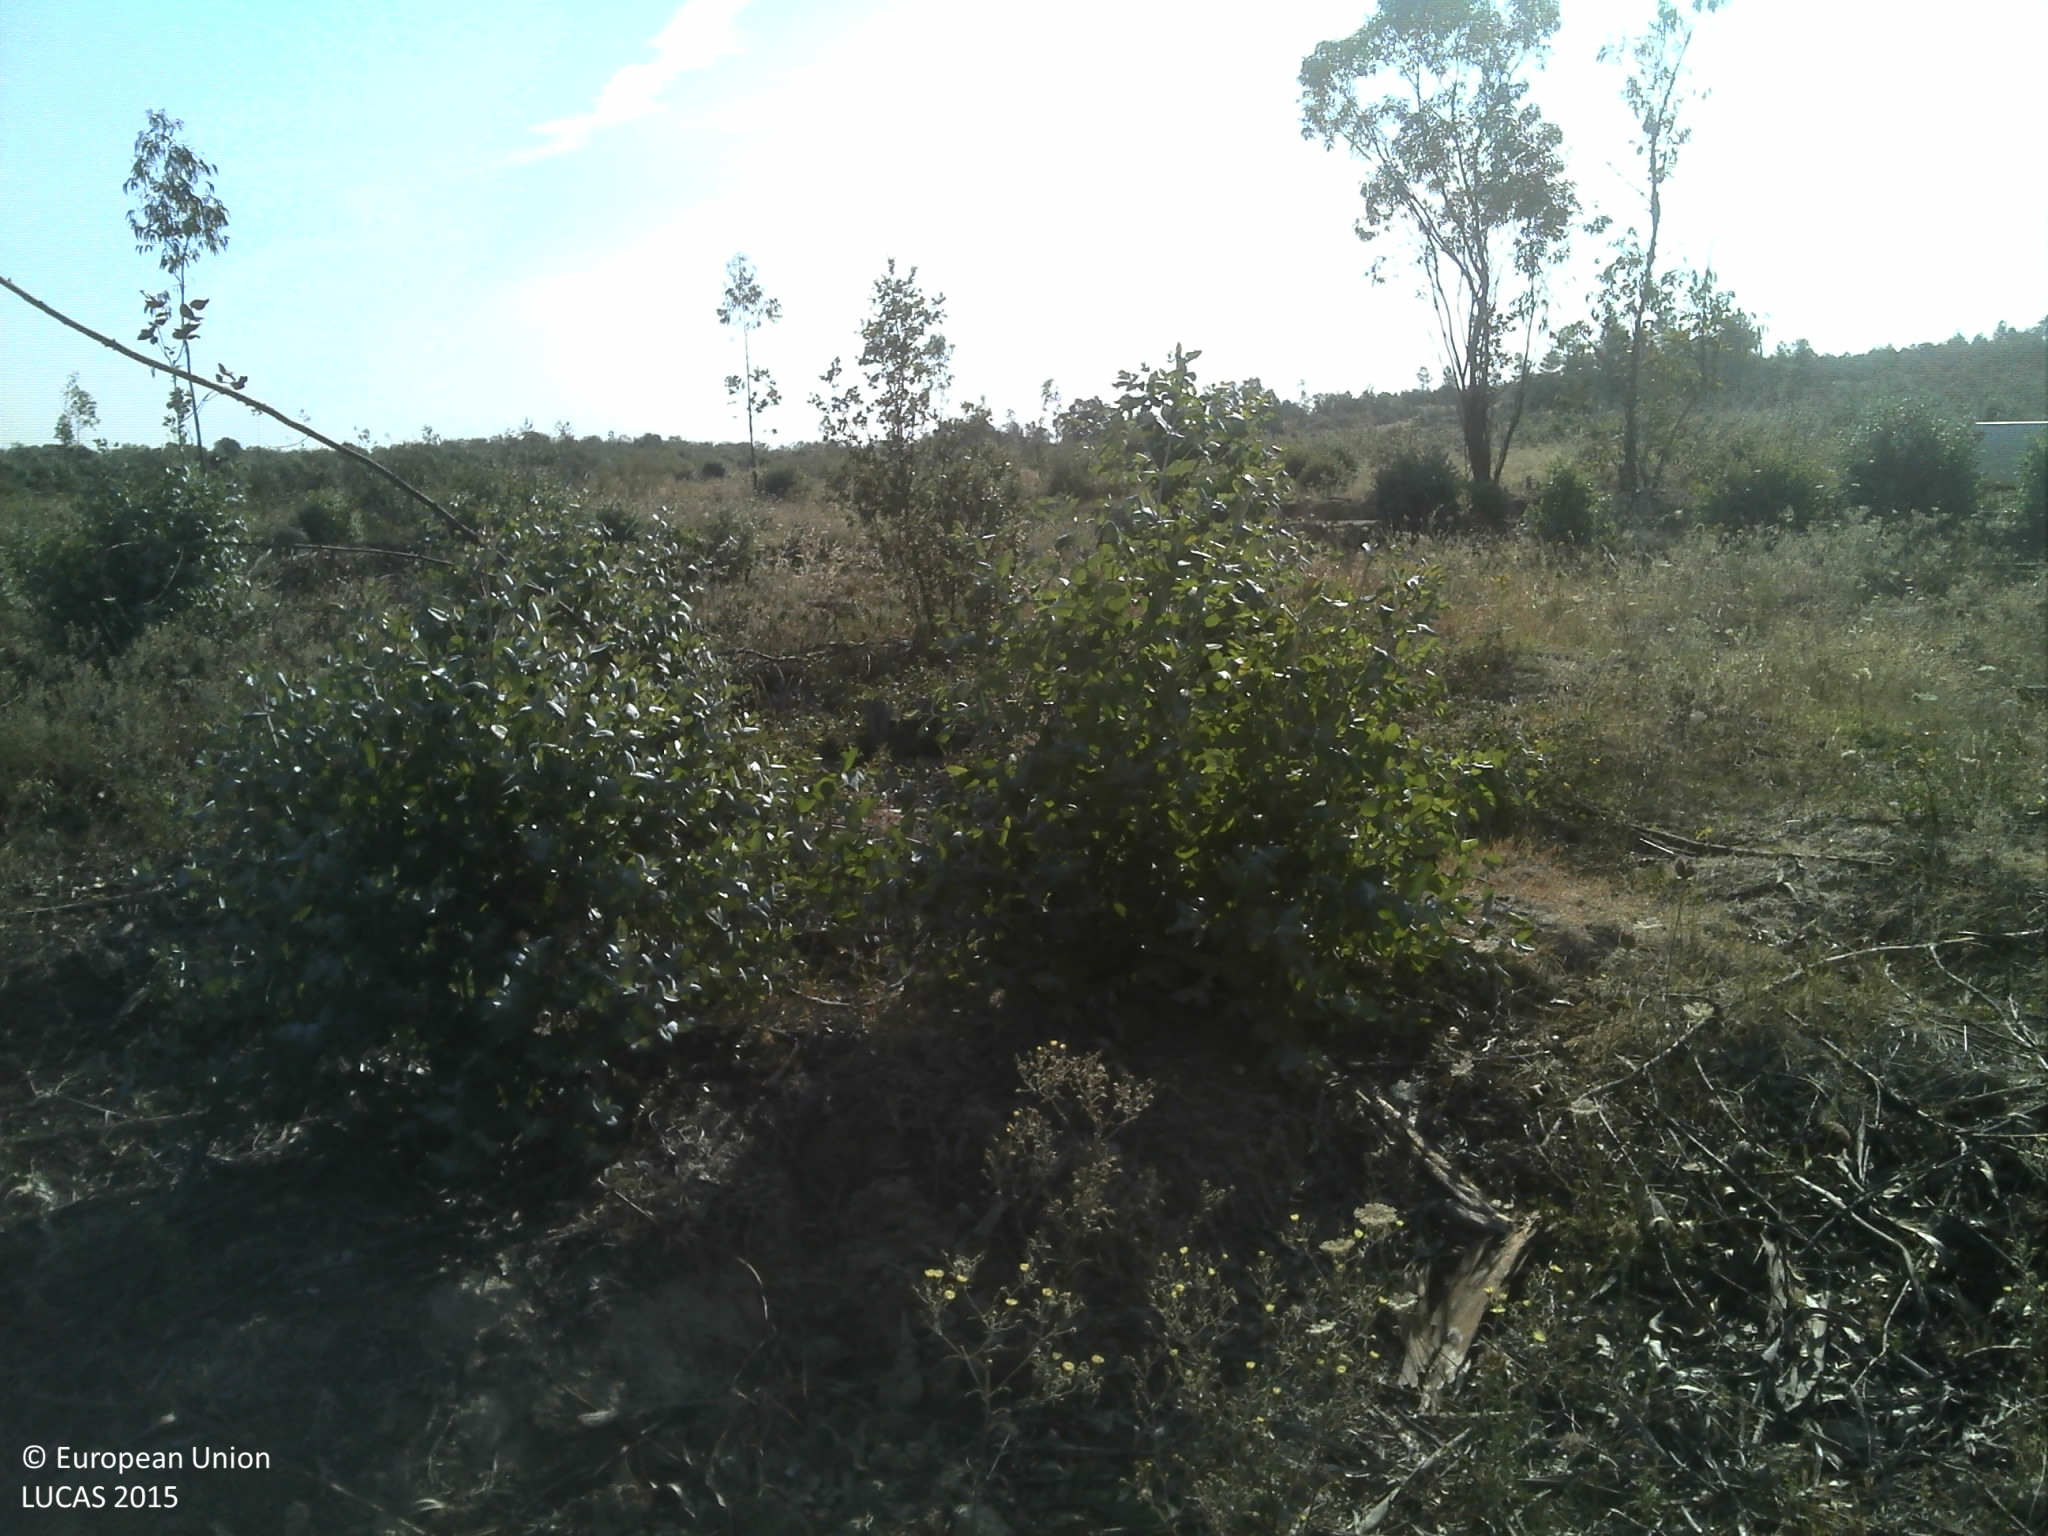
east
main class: Woodland
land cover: Broadleaved woodland
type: exotic forest
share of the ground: 25 - 50 %
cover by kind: unconsolidated bare surface 65 %, broadleaved forest trees 25 %, shrubs 10 %
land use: Forestry
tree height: < 5 m
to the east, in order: Broadleaved woodland; Tracks; Broadleaved woodland; Tracks; Broadleaved woodland
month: June
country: PT
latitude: 39.9267
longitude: -7.1405
